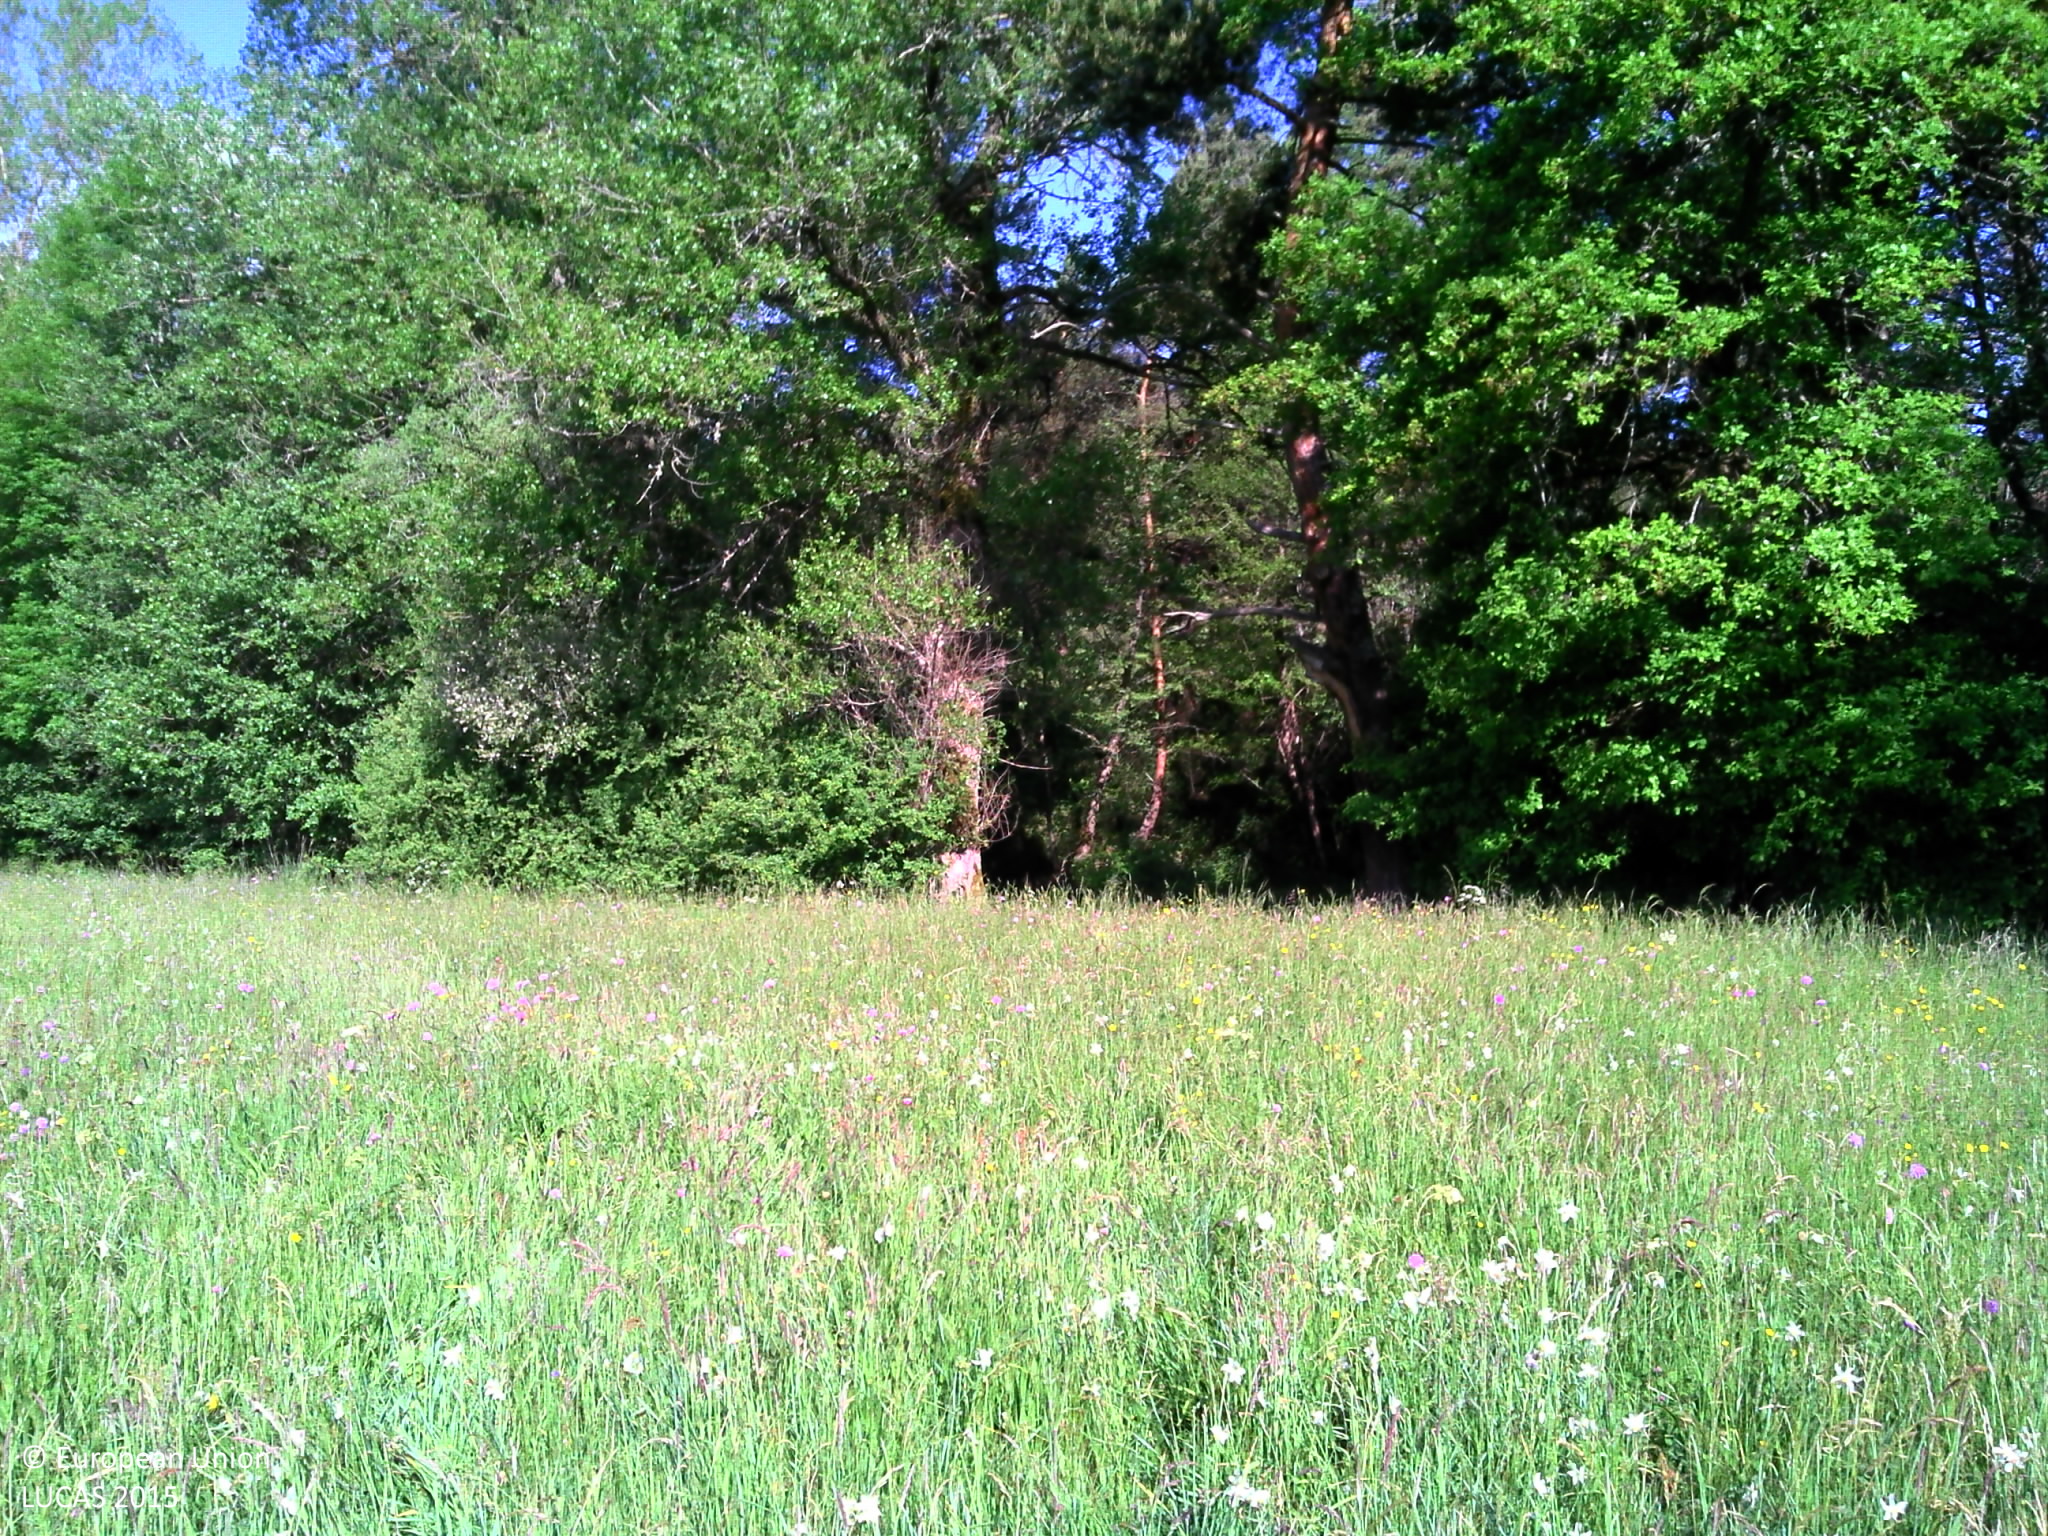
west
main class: Grassland
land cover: Grassland without tree/shrub cover
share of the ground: > 75 %
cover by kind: herbaceous plants 100 %
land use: Agriculture (excluding fallow land and kitchen gardens)
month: June
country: FR
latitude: 44.9625
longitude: 3.2458
